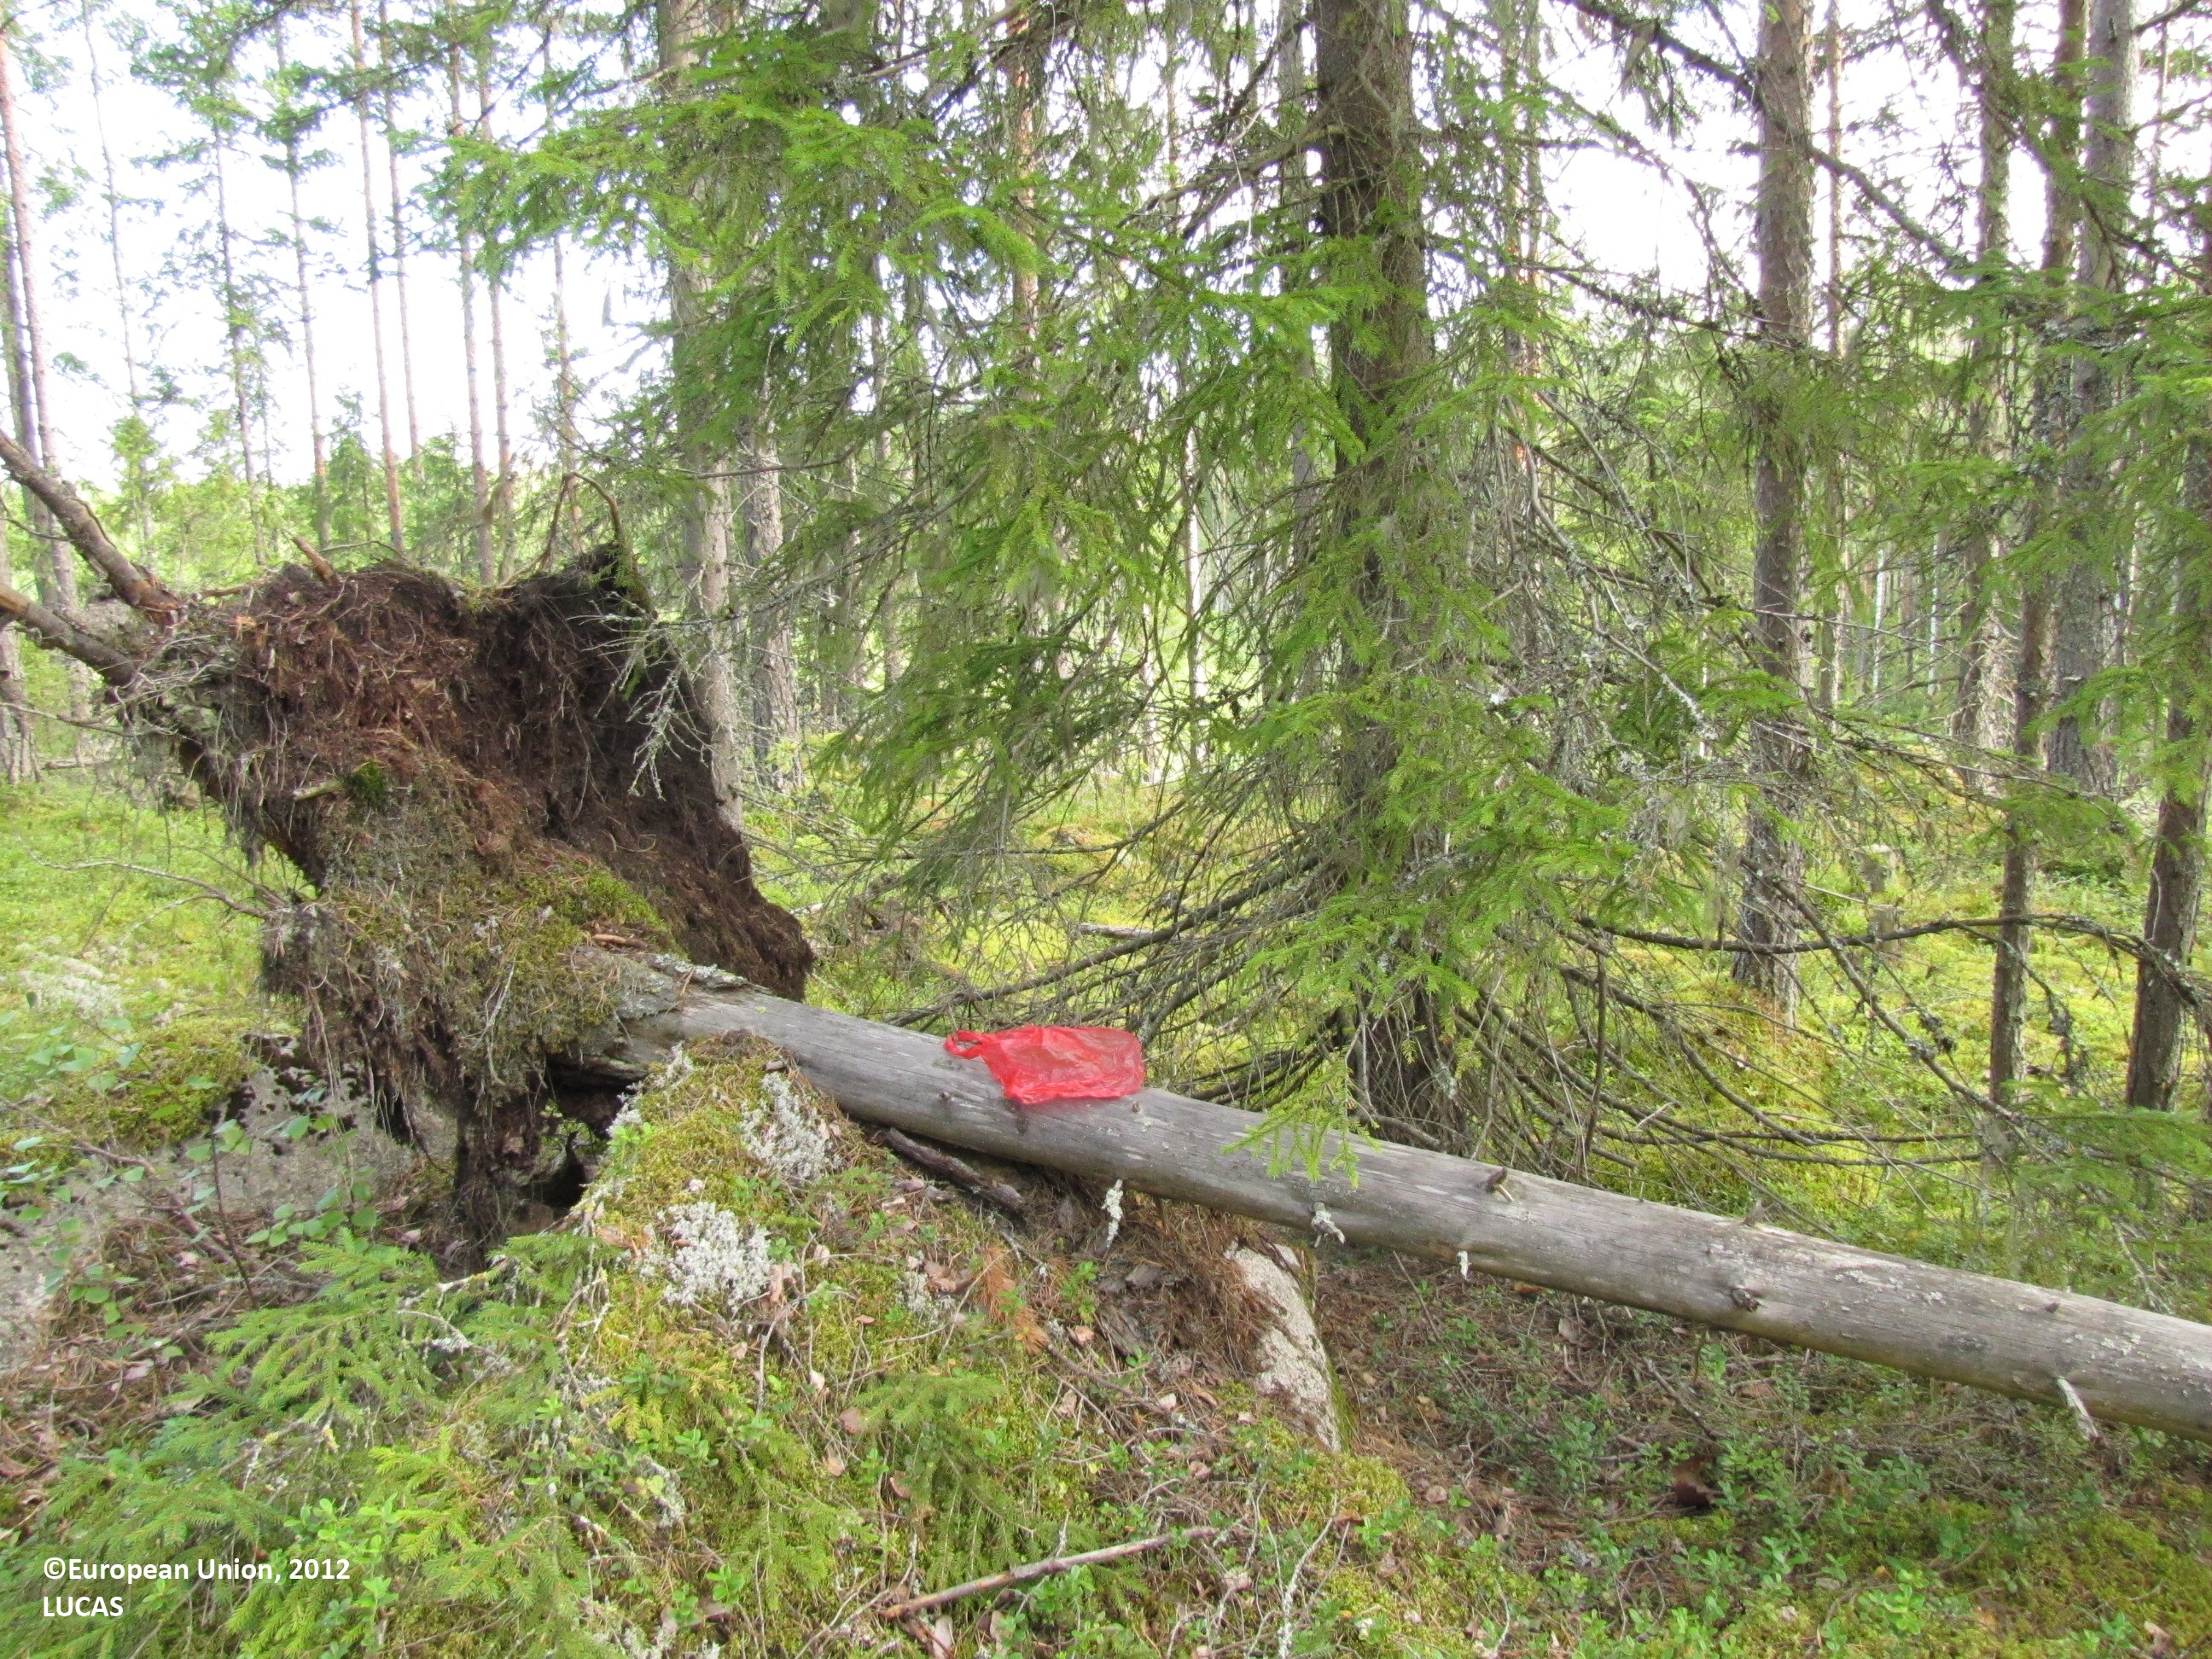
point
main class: Woodland
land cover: Other coniferous woodland
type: boreal forest
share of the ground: 50 - 75 %
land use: Forestry
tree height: > 5 m
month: August
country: FI
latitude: 61.8062
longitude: 23.2208
